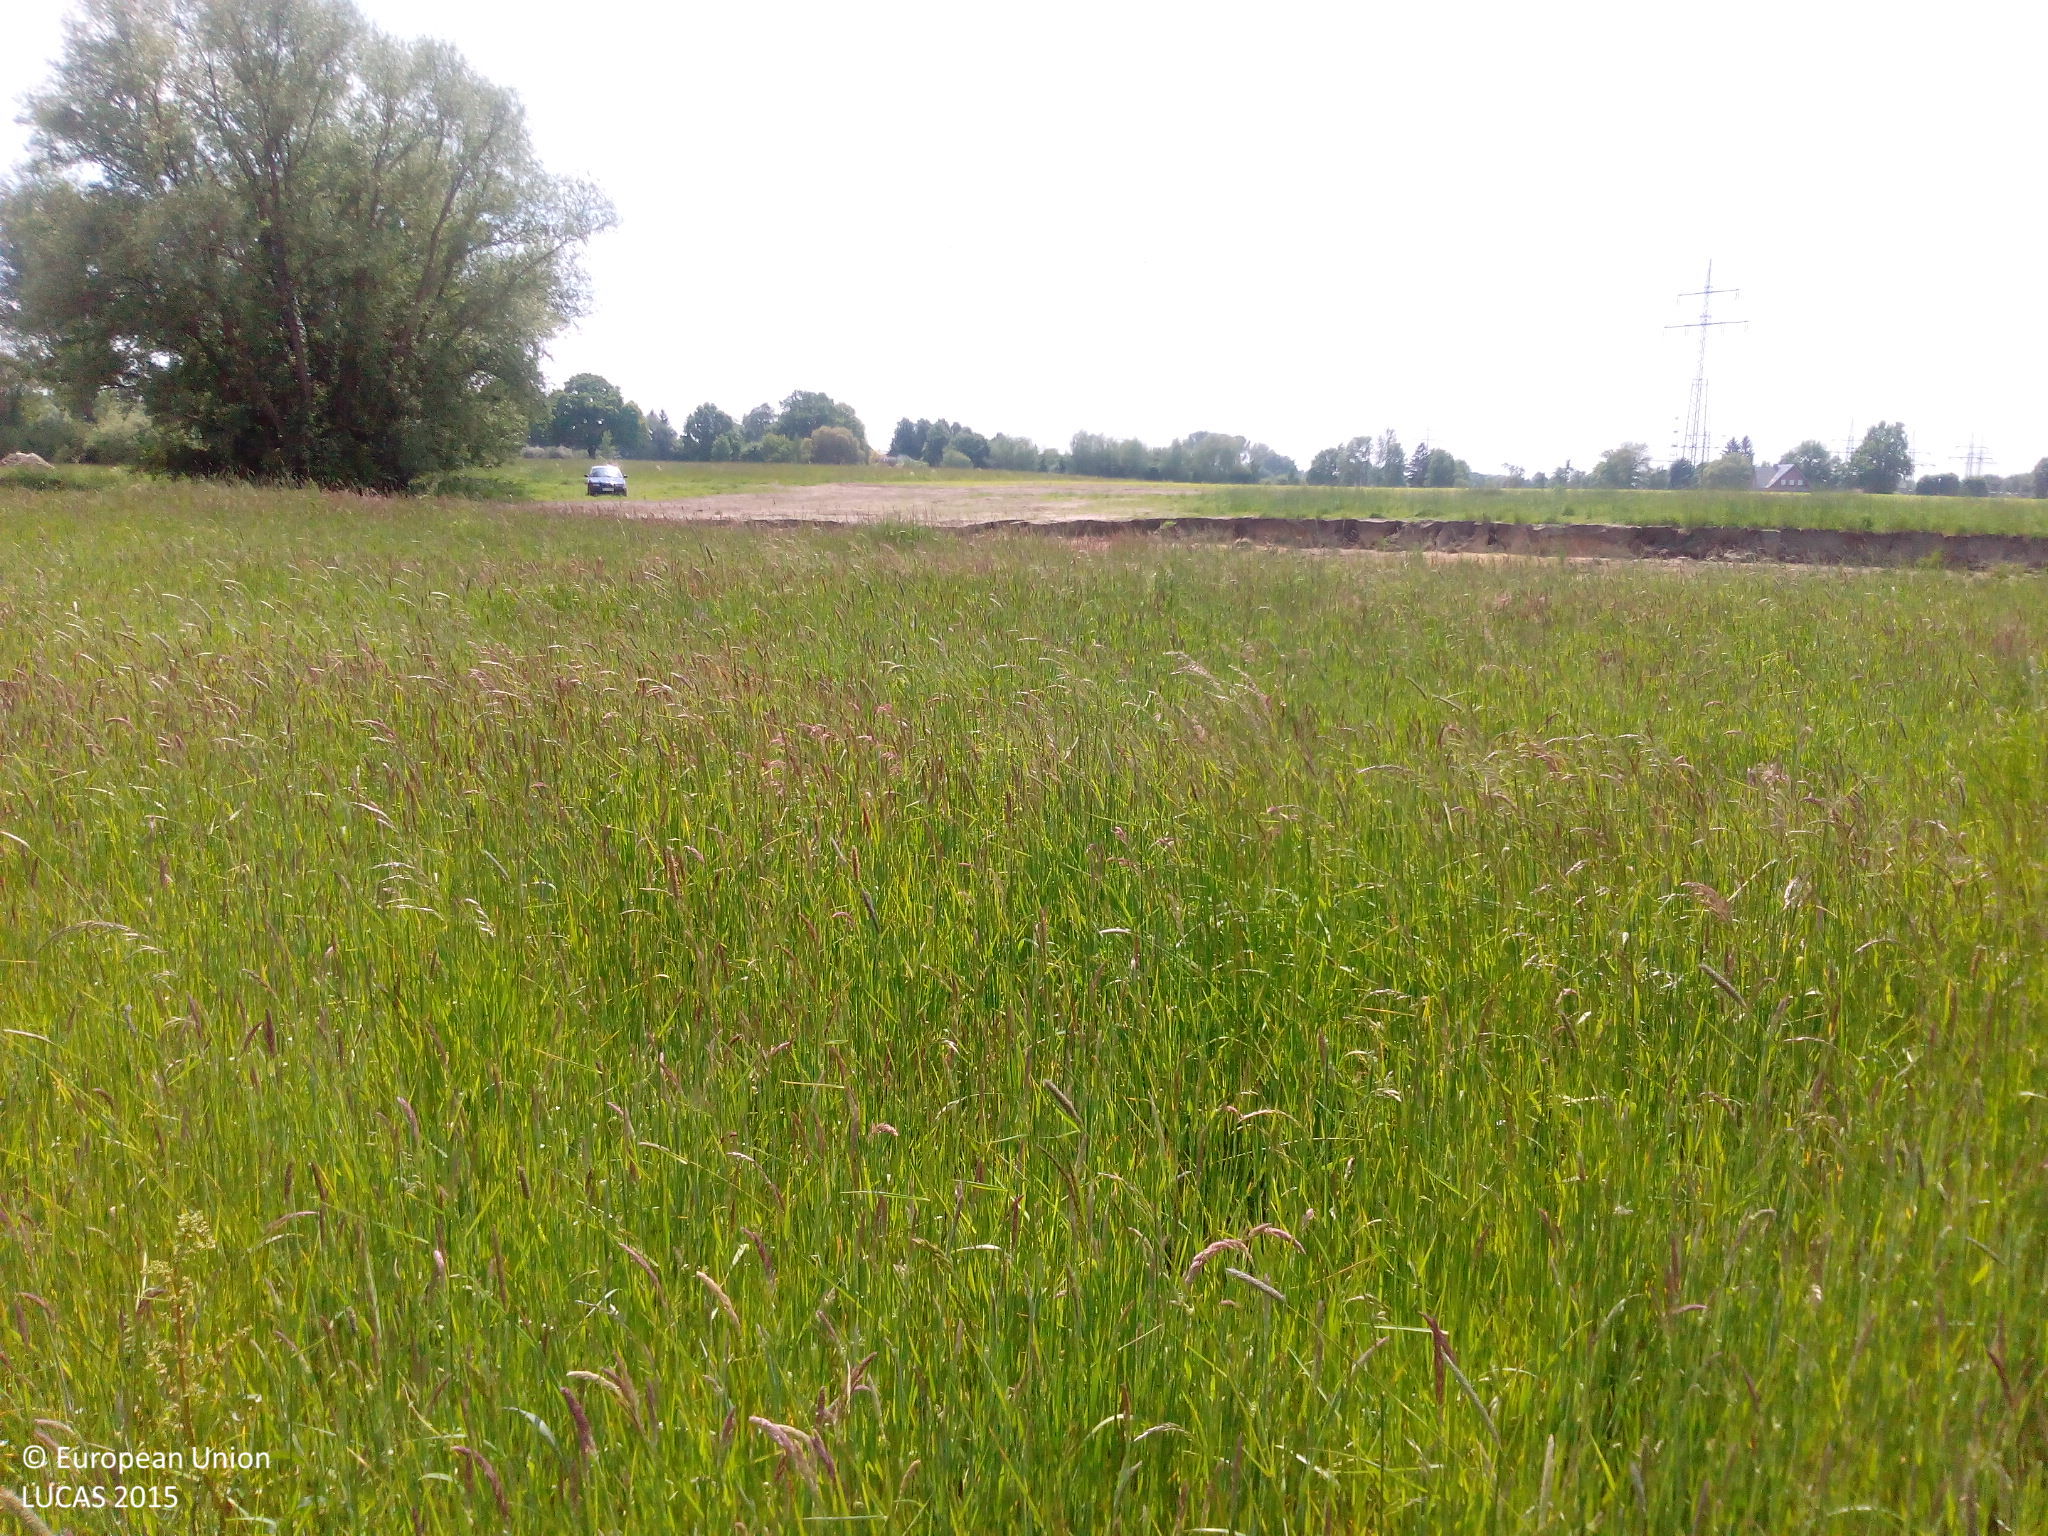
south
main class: Grassland
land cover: Grassland without tree/shrub cover
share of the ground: > 75 %
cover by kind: herbaceous plants 100 %
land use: Agriculture (excluding fallow land and kitchen gardens)
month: May
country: DE
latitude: 51.6772
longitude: 7.9902
